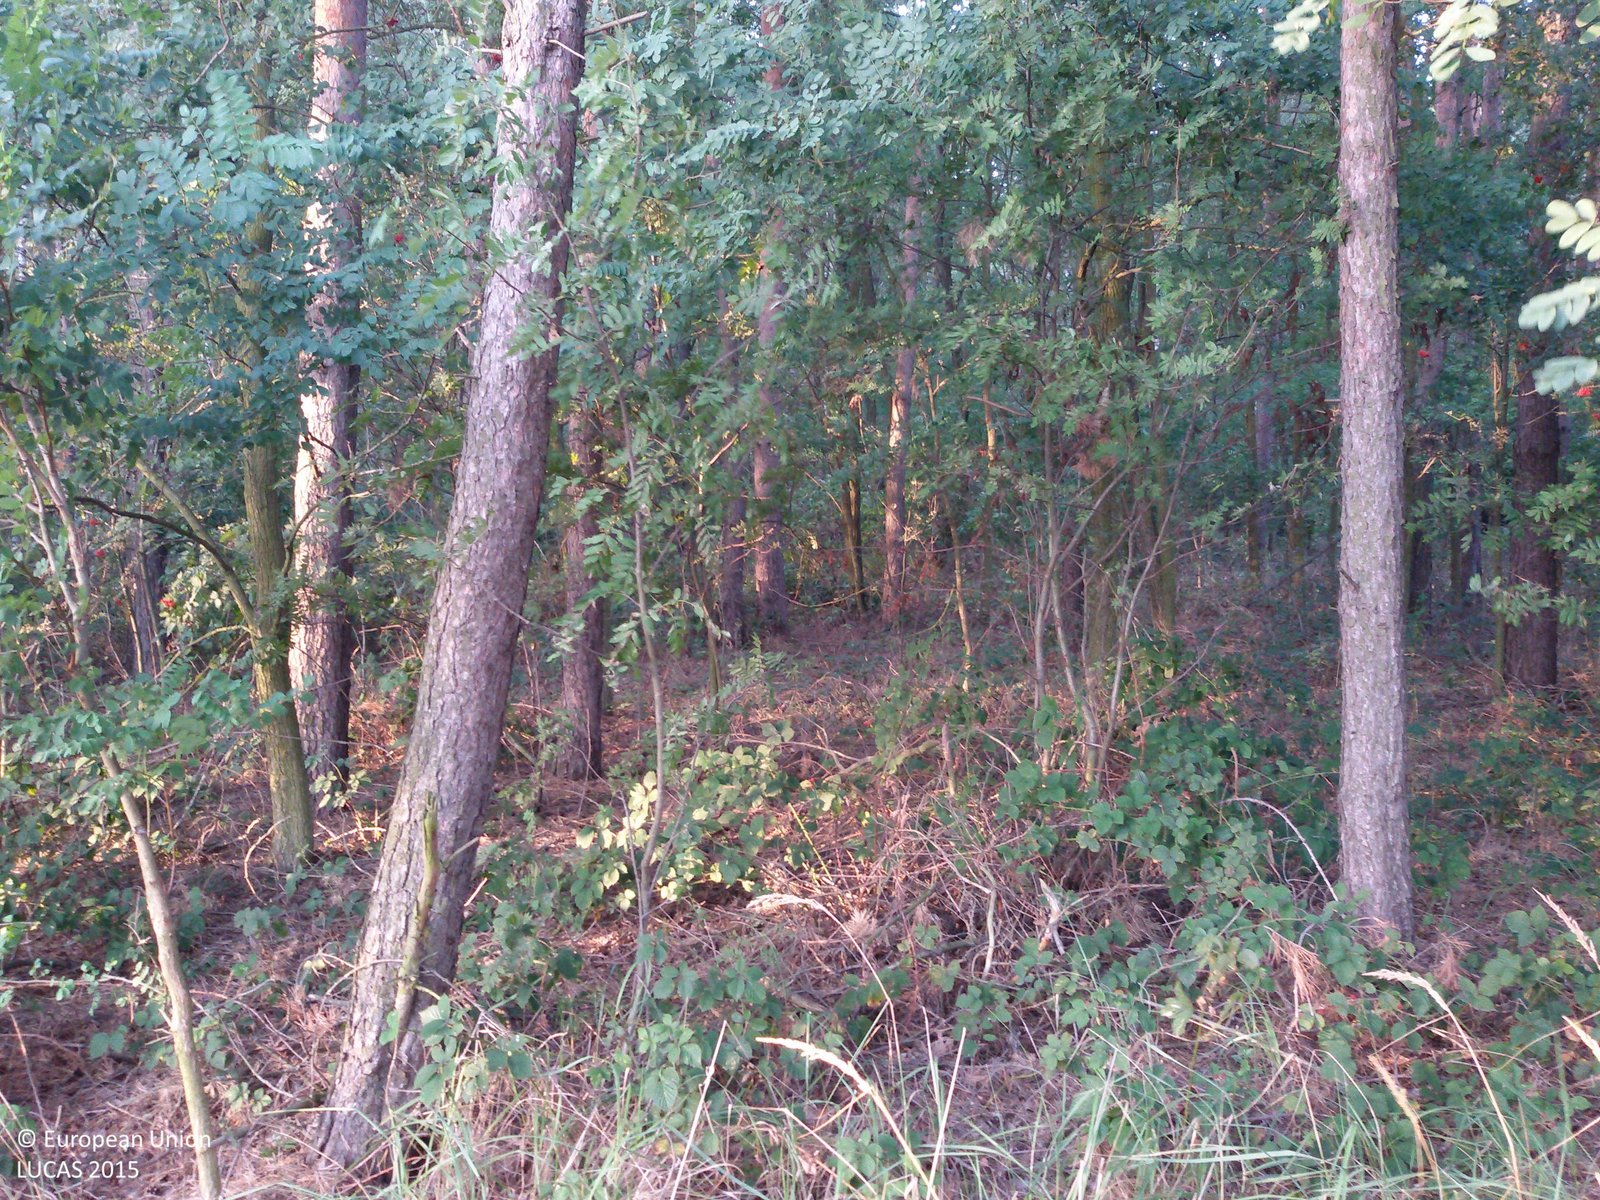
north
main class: Woodland
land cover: Pine dominated coniferous woodland
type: hemiboreal forest and nemoral coniferous forest and mixed broadleaved-coniferous forest
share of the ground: > 75 %
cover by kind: coniferous forest trees 60 %, broadleaved forest trees 20 %, herbaceous plants 10 %, unconsolidated bare surface 10 %
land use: Forestry
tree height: > 5 m
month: September
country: PL
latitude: 52.4145
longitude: 17.9989
